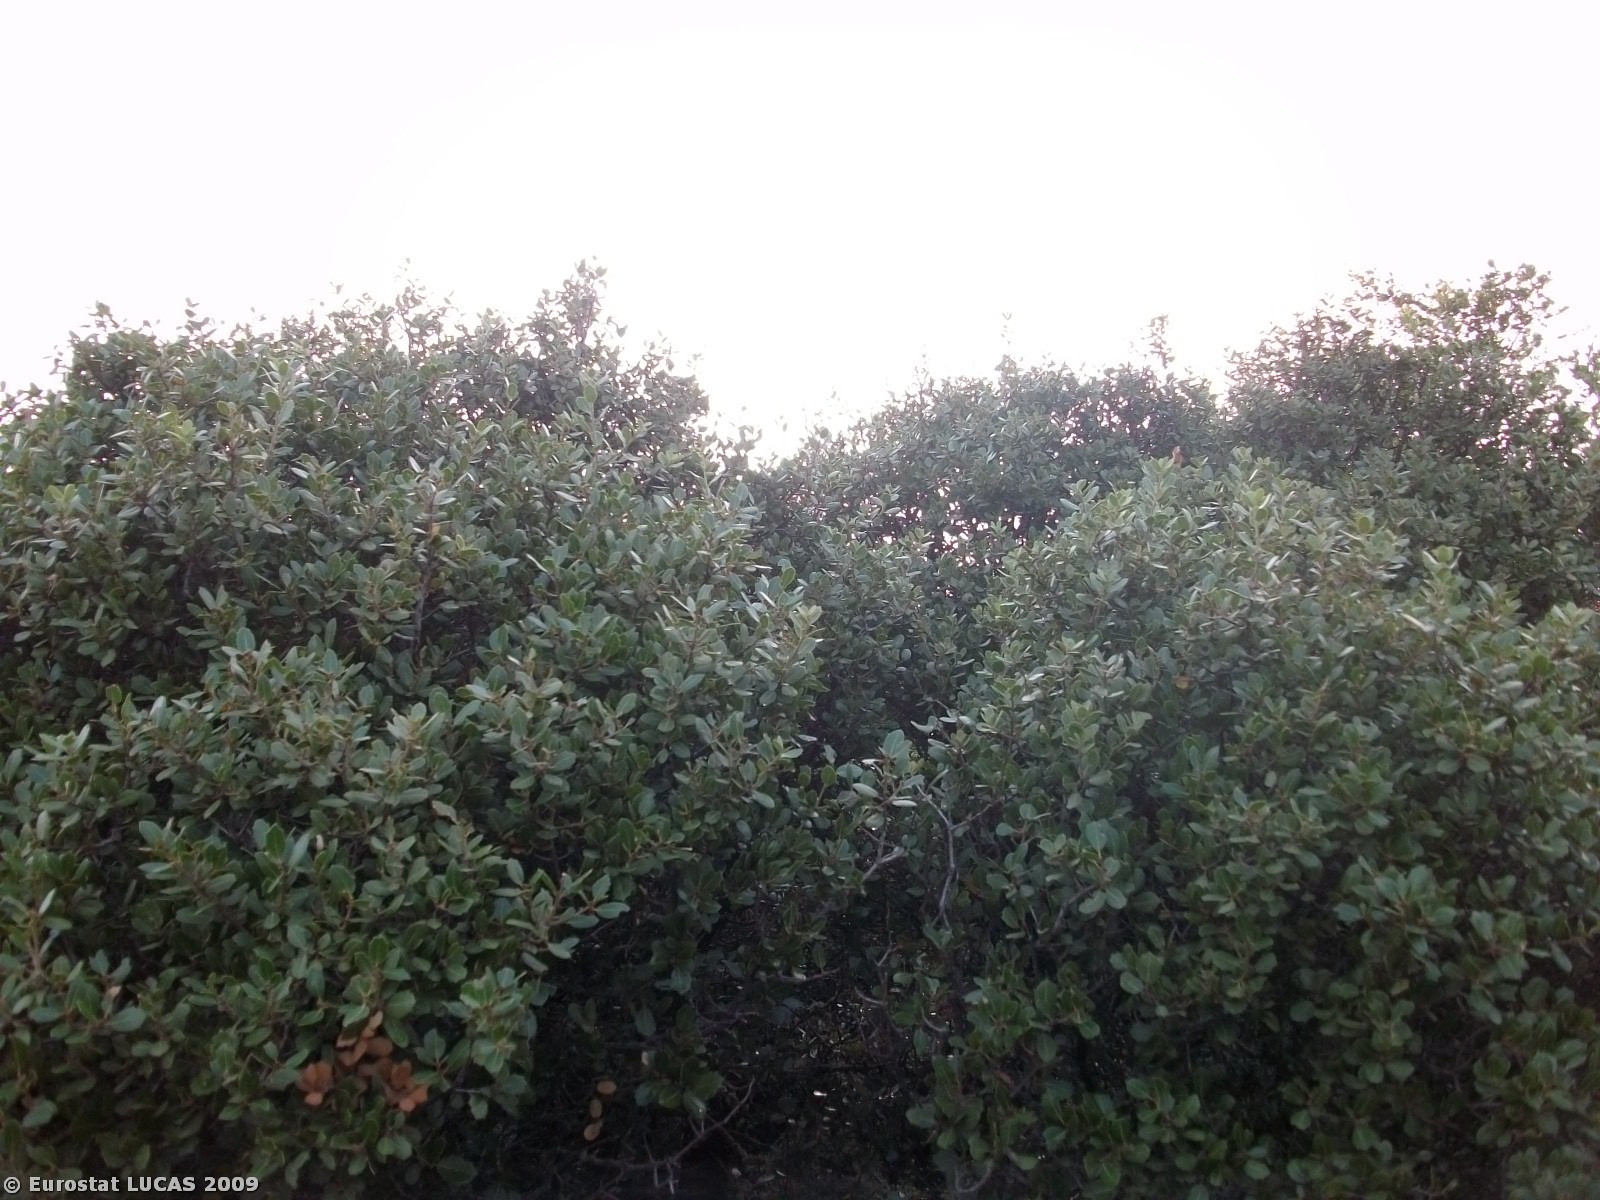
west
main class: Shrubland
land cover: Shrubland without tree cover
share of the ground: > 75 %
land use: Unused
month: August
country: GR
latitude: 38.9758
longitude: 22.4596
